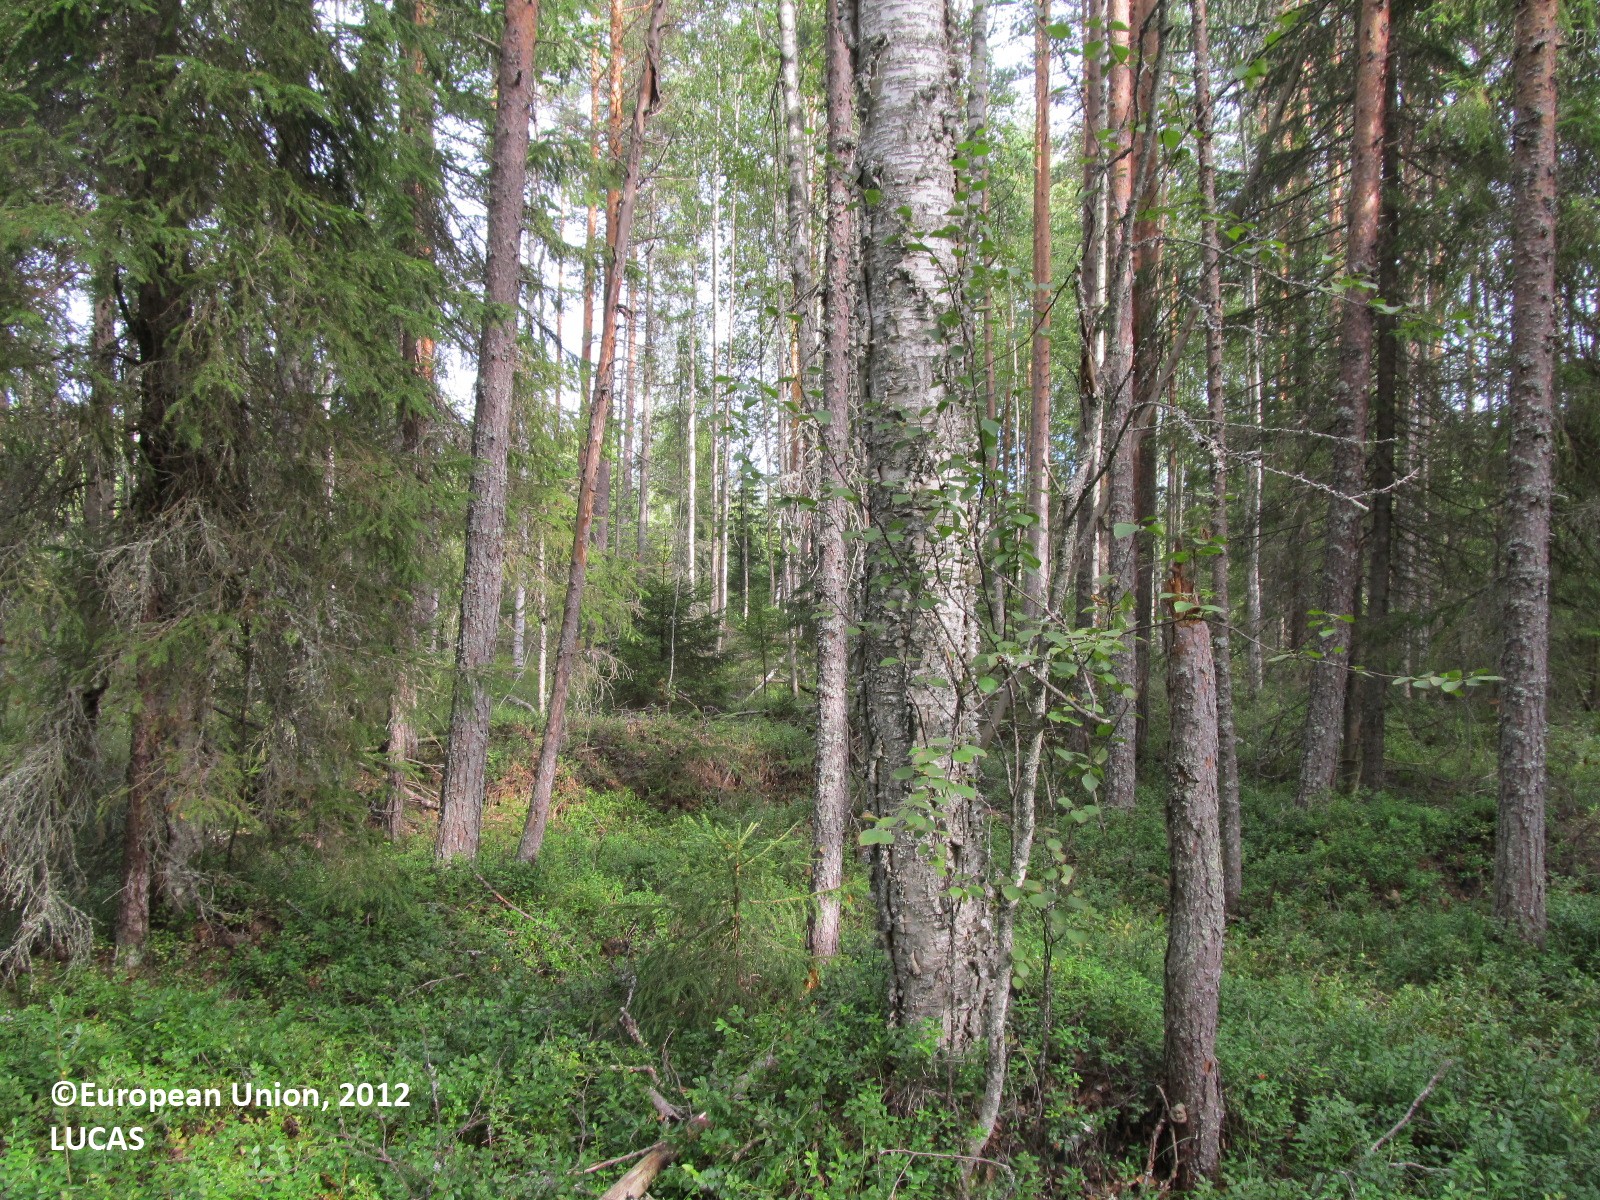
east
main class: Woodland
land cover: Pine dominated coniferous woodland
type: boreal forest
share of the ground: 25 - 50 %
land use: Forestry
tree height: > 5 m
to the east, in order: Pine dominated coniferous woodland; Ditches and canals; Pine dominated mixed woodland; Ditches and canals; Pine dominated mixed woodland; Broadleaved woodland; Pine dominated coniferous woodland; Inland water bodies
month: August
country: FI
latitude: 62.2922
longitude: 28.4589
